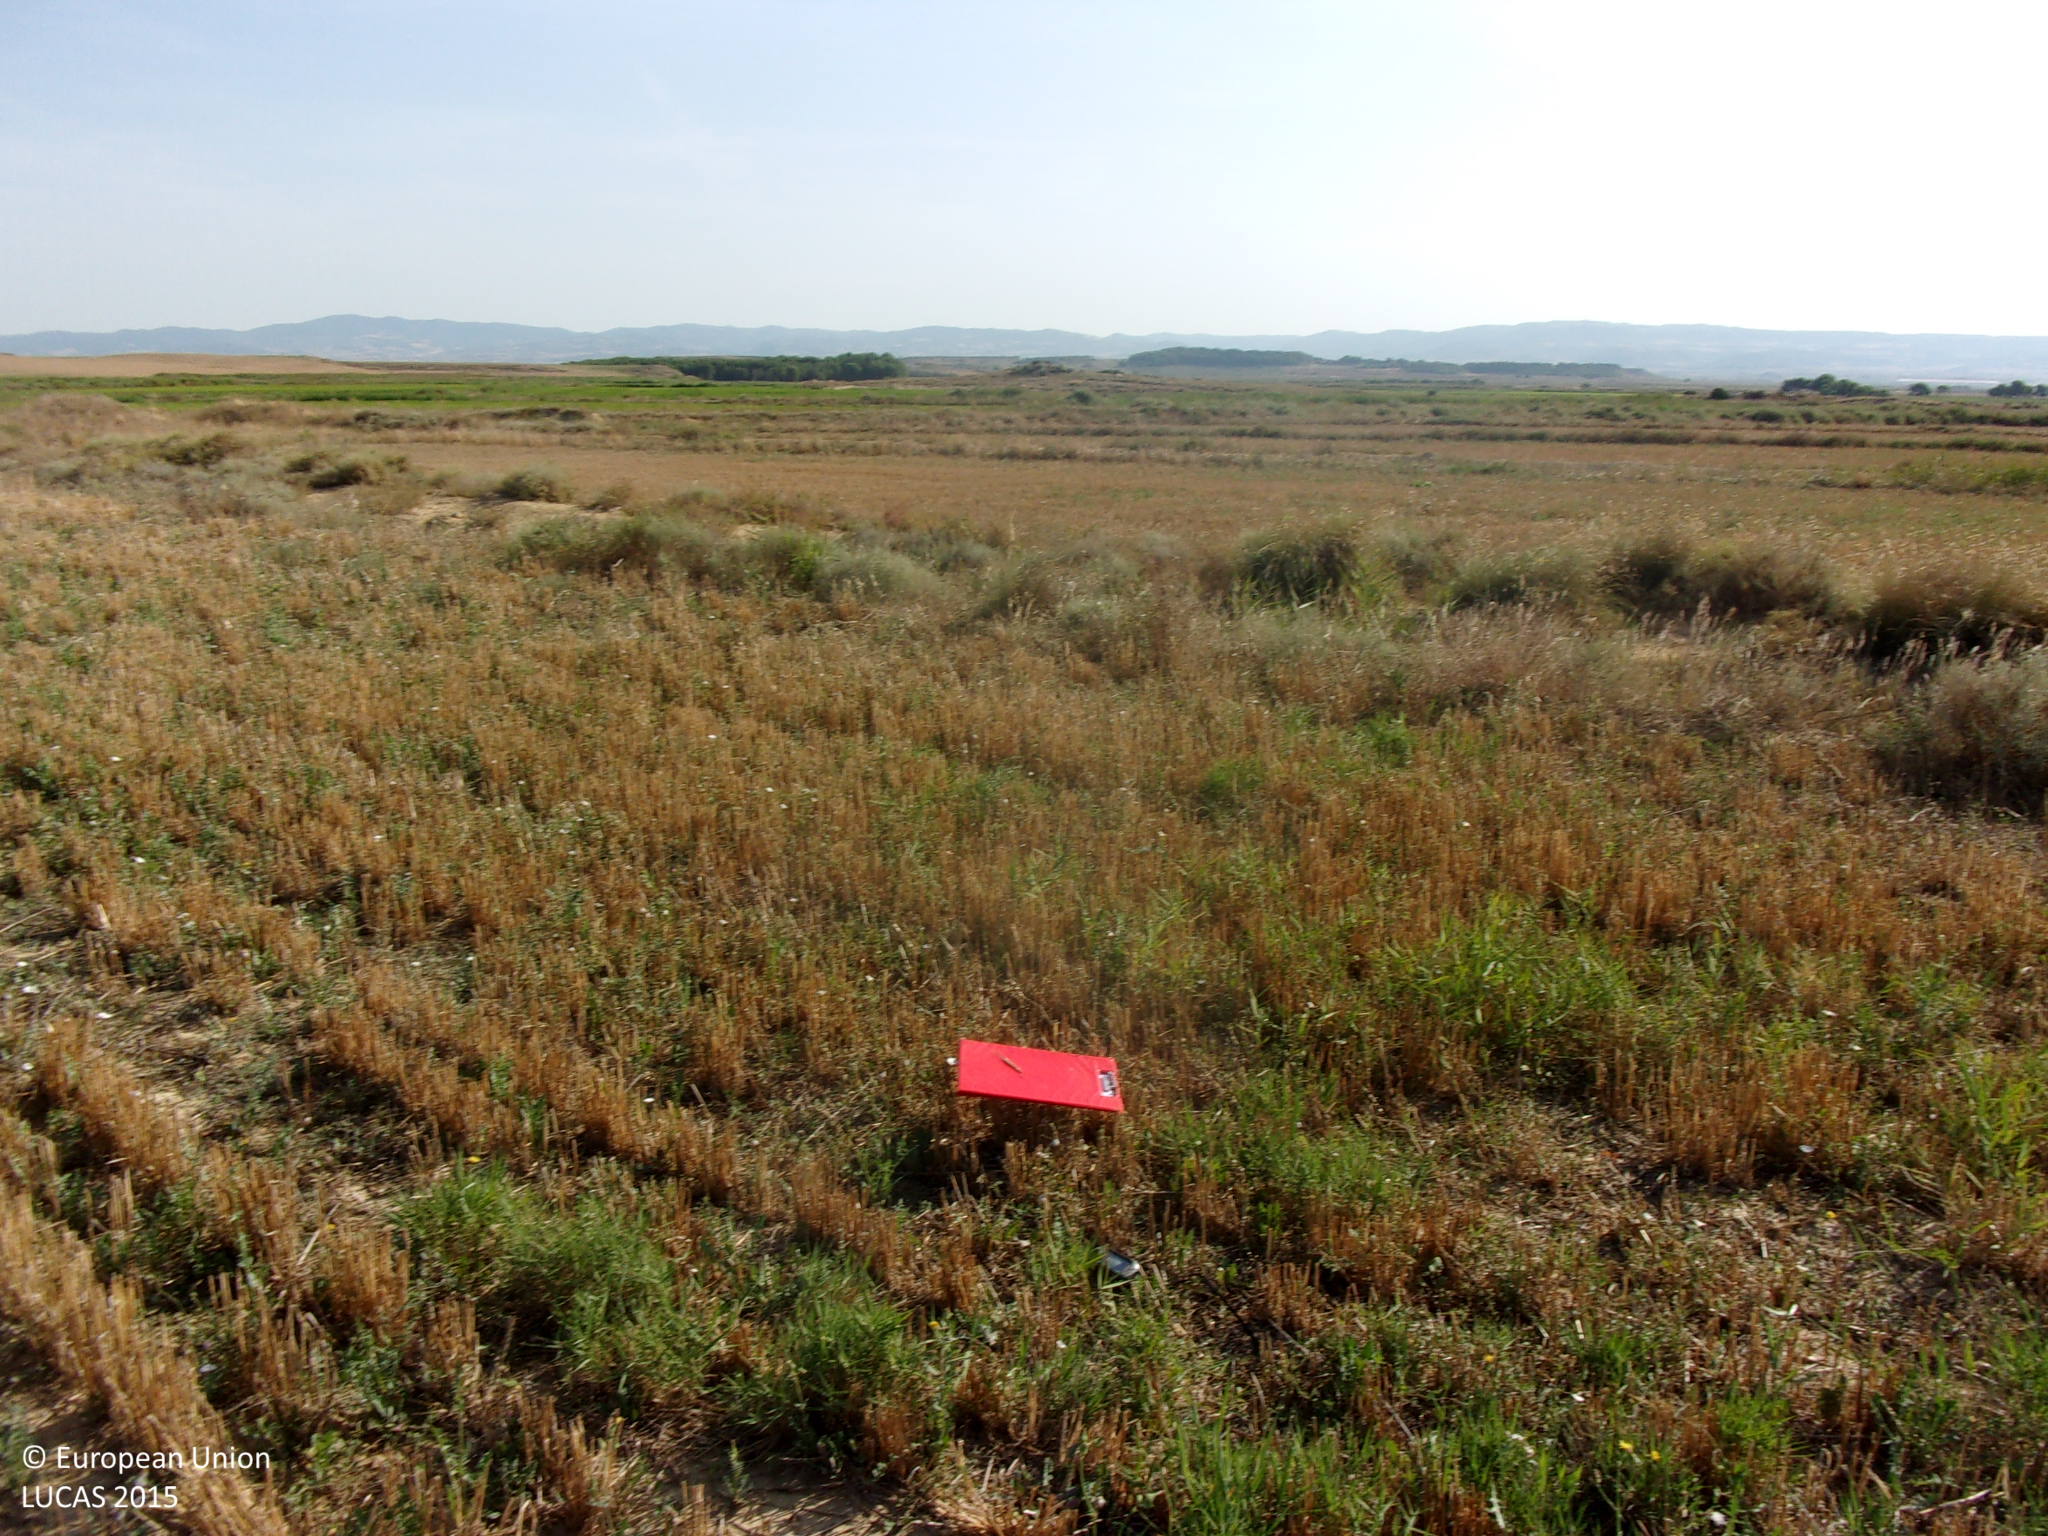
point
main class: Cropland
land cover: Barley
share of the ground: < 10 %
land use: Agriculture (excluding fallow land and kitchen gardens)
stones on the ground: < 10 %
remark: Harvested field
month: August
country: ES
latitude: 42.3205
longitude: -1.3772
